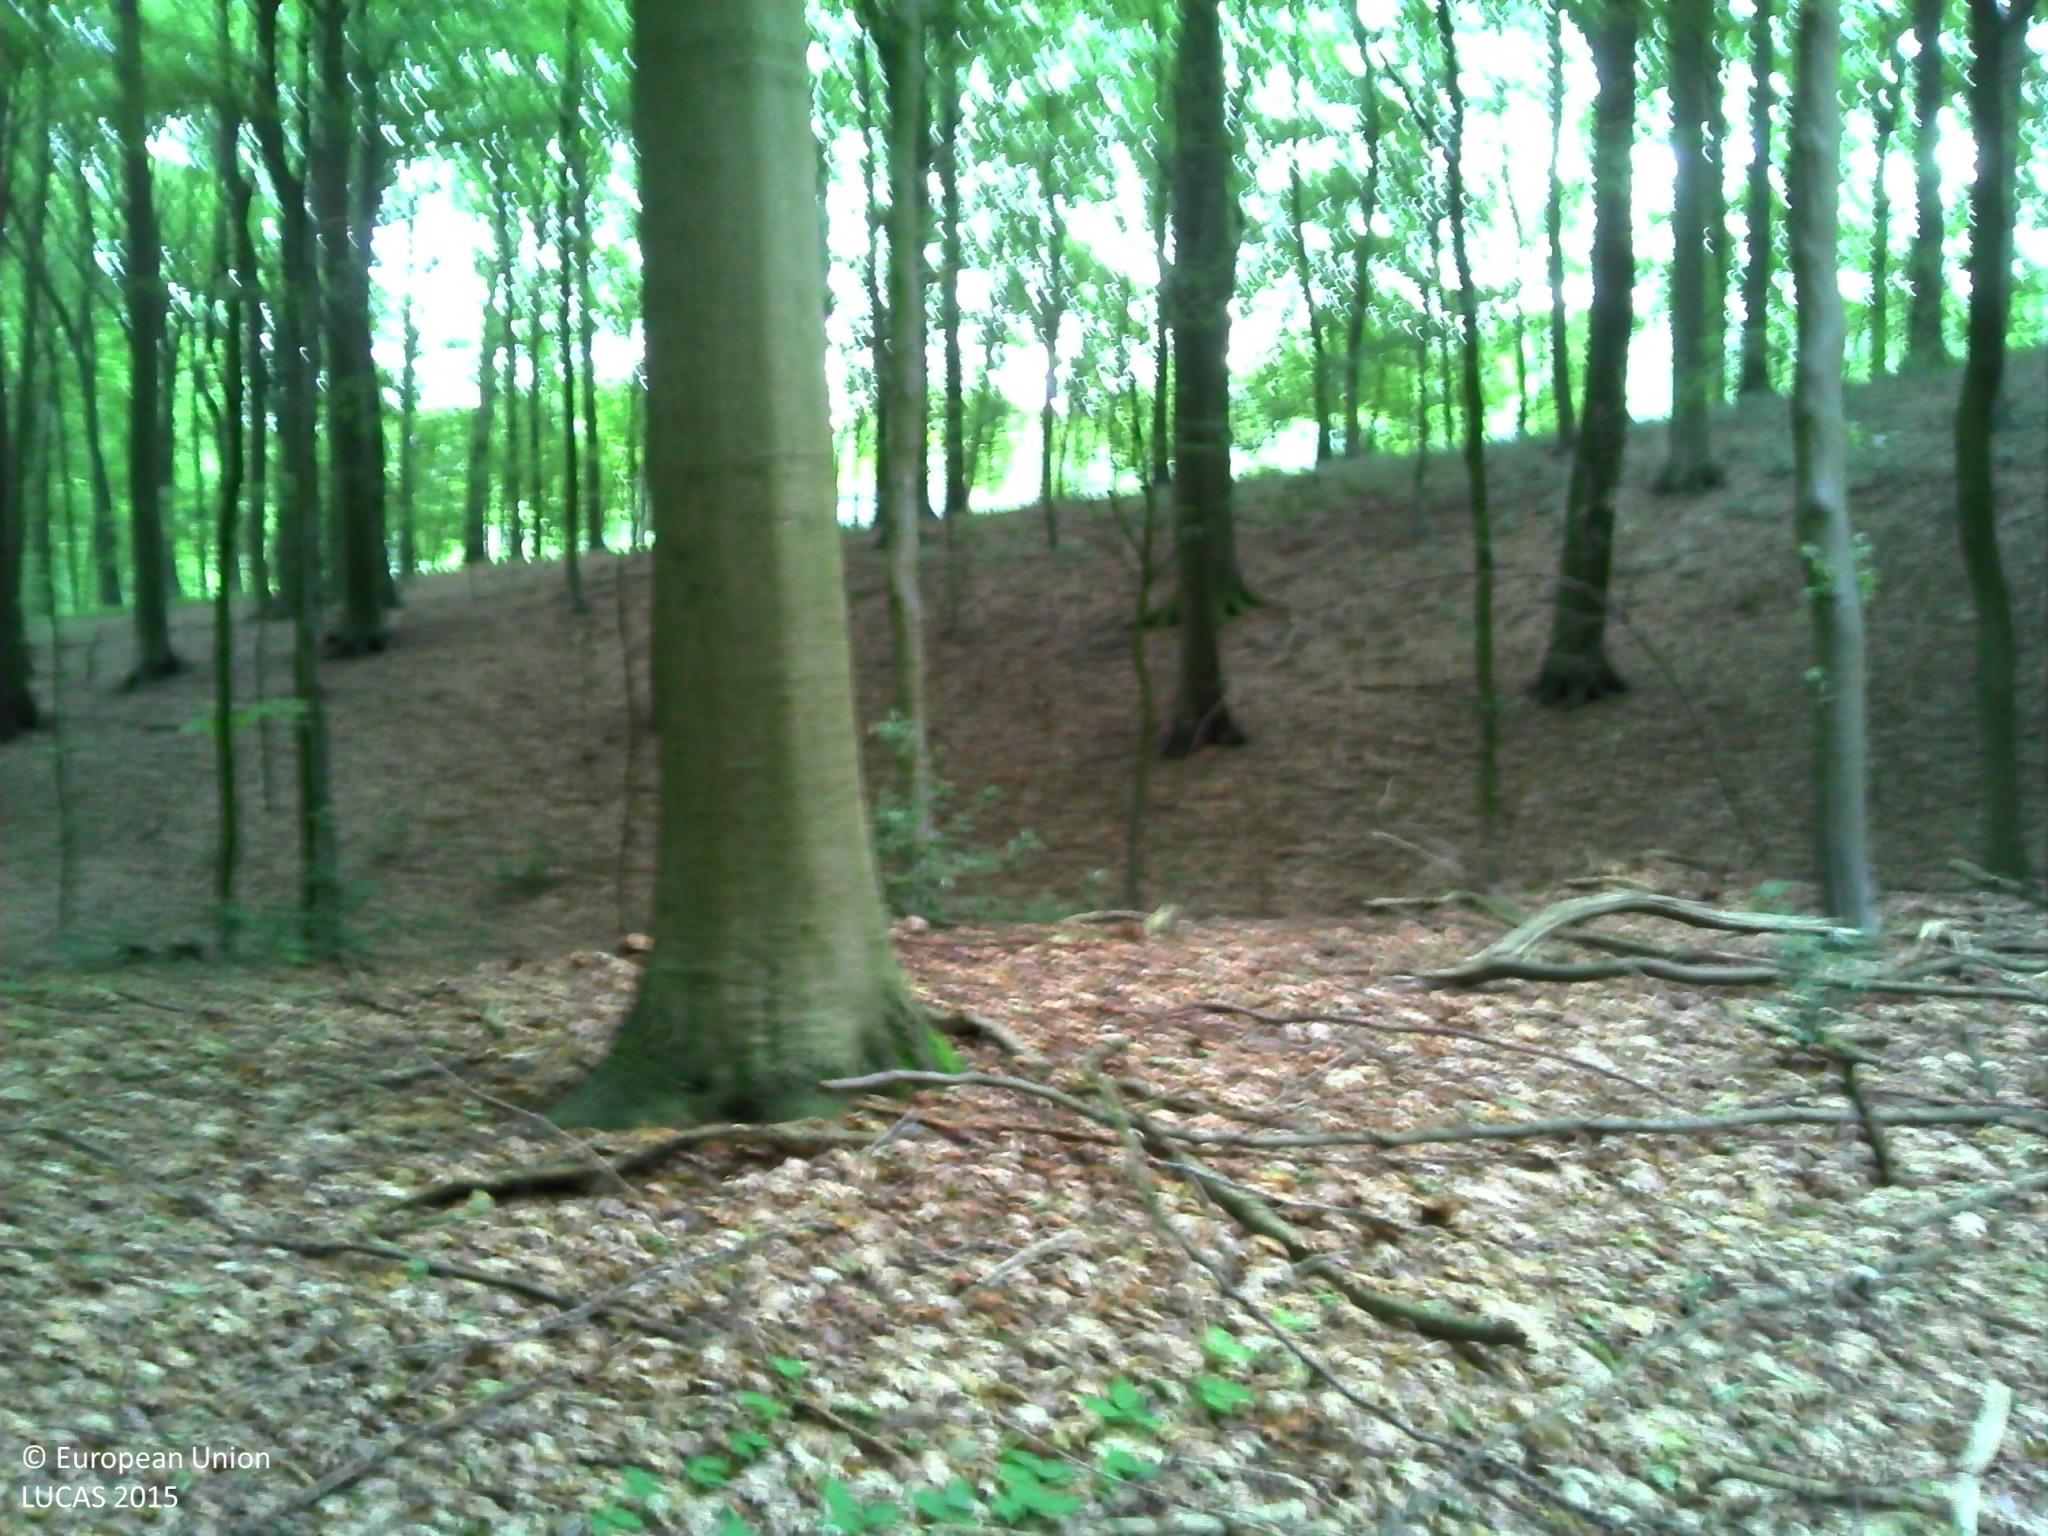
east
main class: Woodland
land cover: Broadleaved woodland
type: beech forest
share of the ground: > 75 %
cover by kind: broadleaved forest trees 90 %, shrubs 5 %, herbaceous plants 5 %
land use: Forestry
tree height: > 5 m
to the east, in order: Broadleaved woodland; Grass margins; Tracks; Grass margins; Temporary grasslands; Other leguminous and mixtures for fodder; Electric lines; Other leguminous and mixtures for fodder; Grass margins; Fences; Grassland without tree/shrub cover
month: August
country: BE
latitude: 50.7098
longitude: 3.6343
